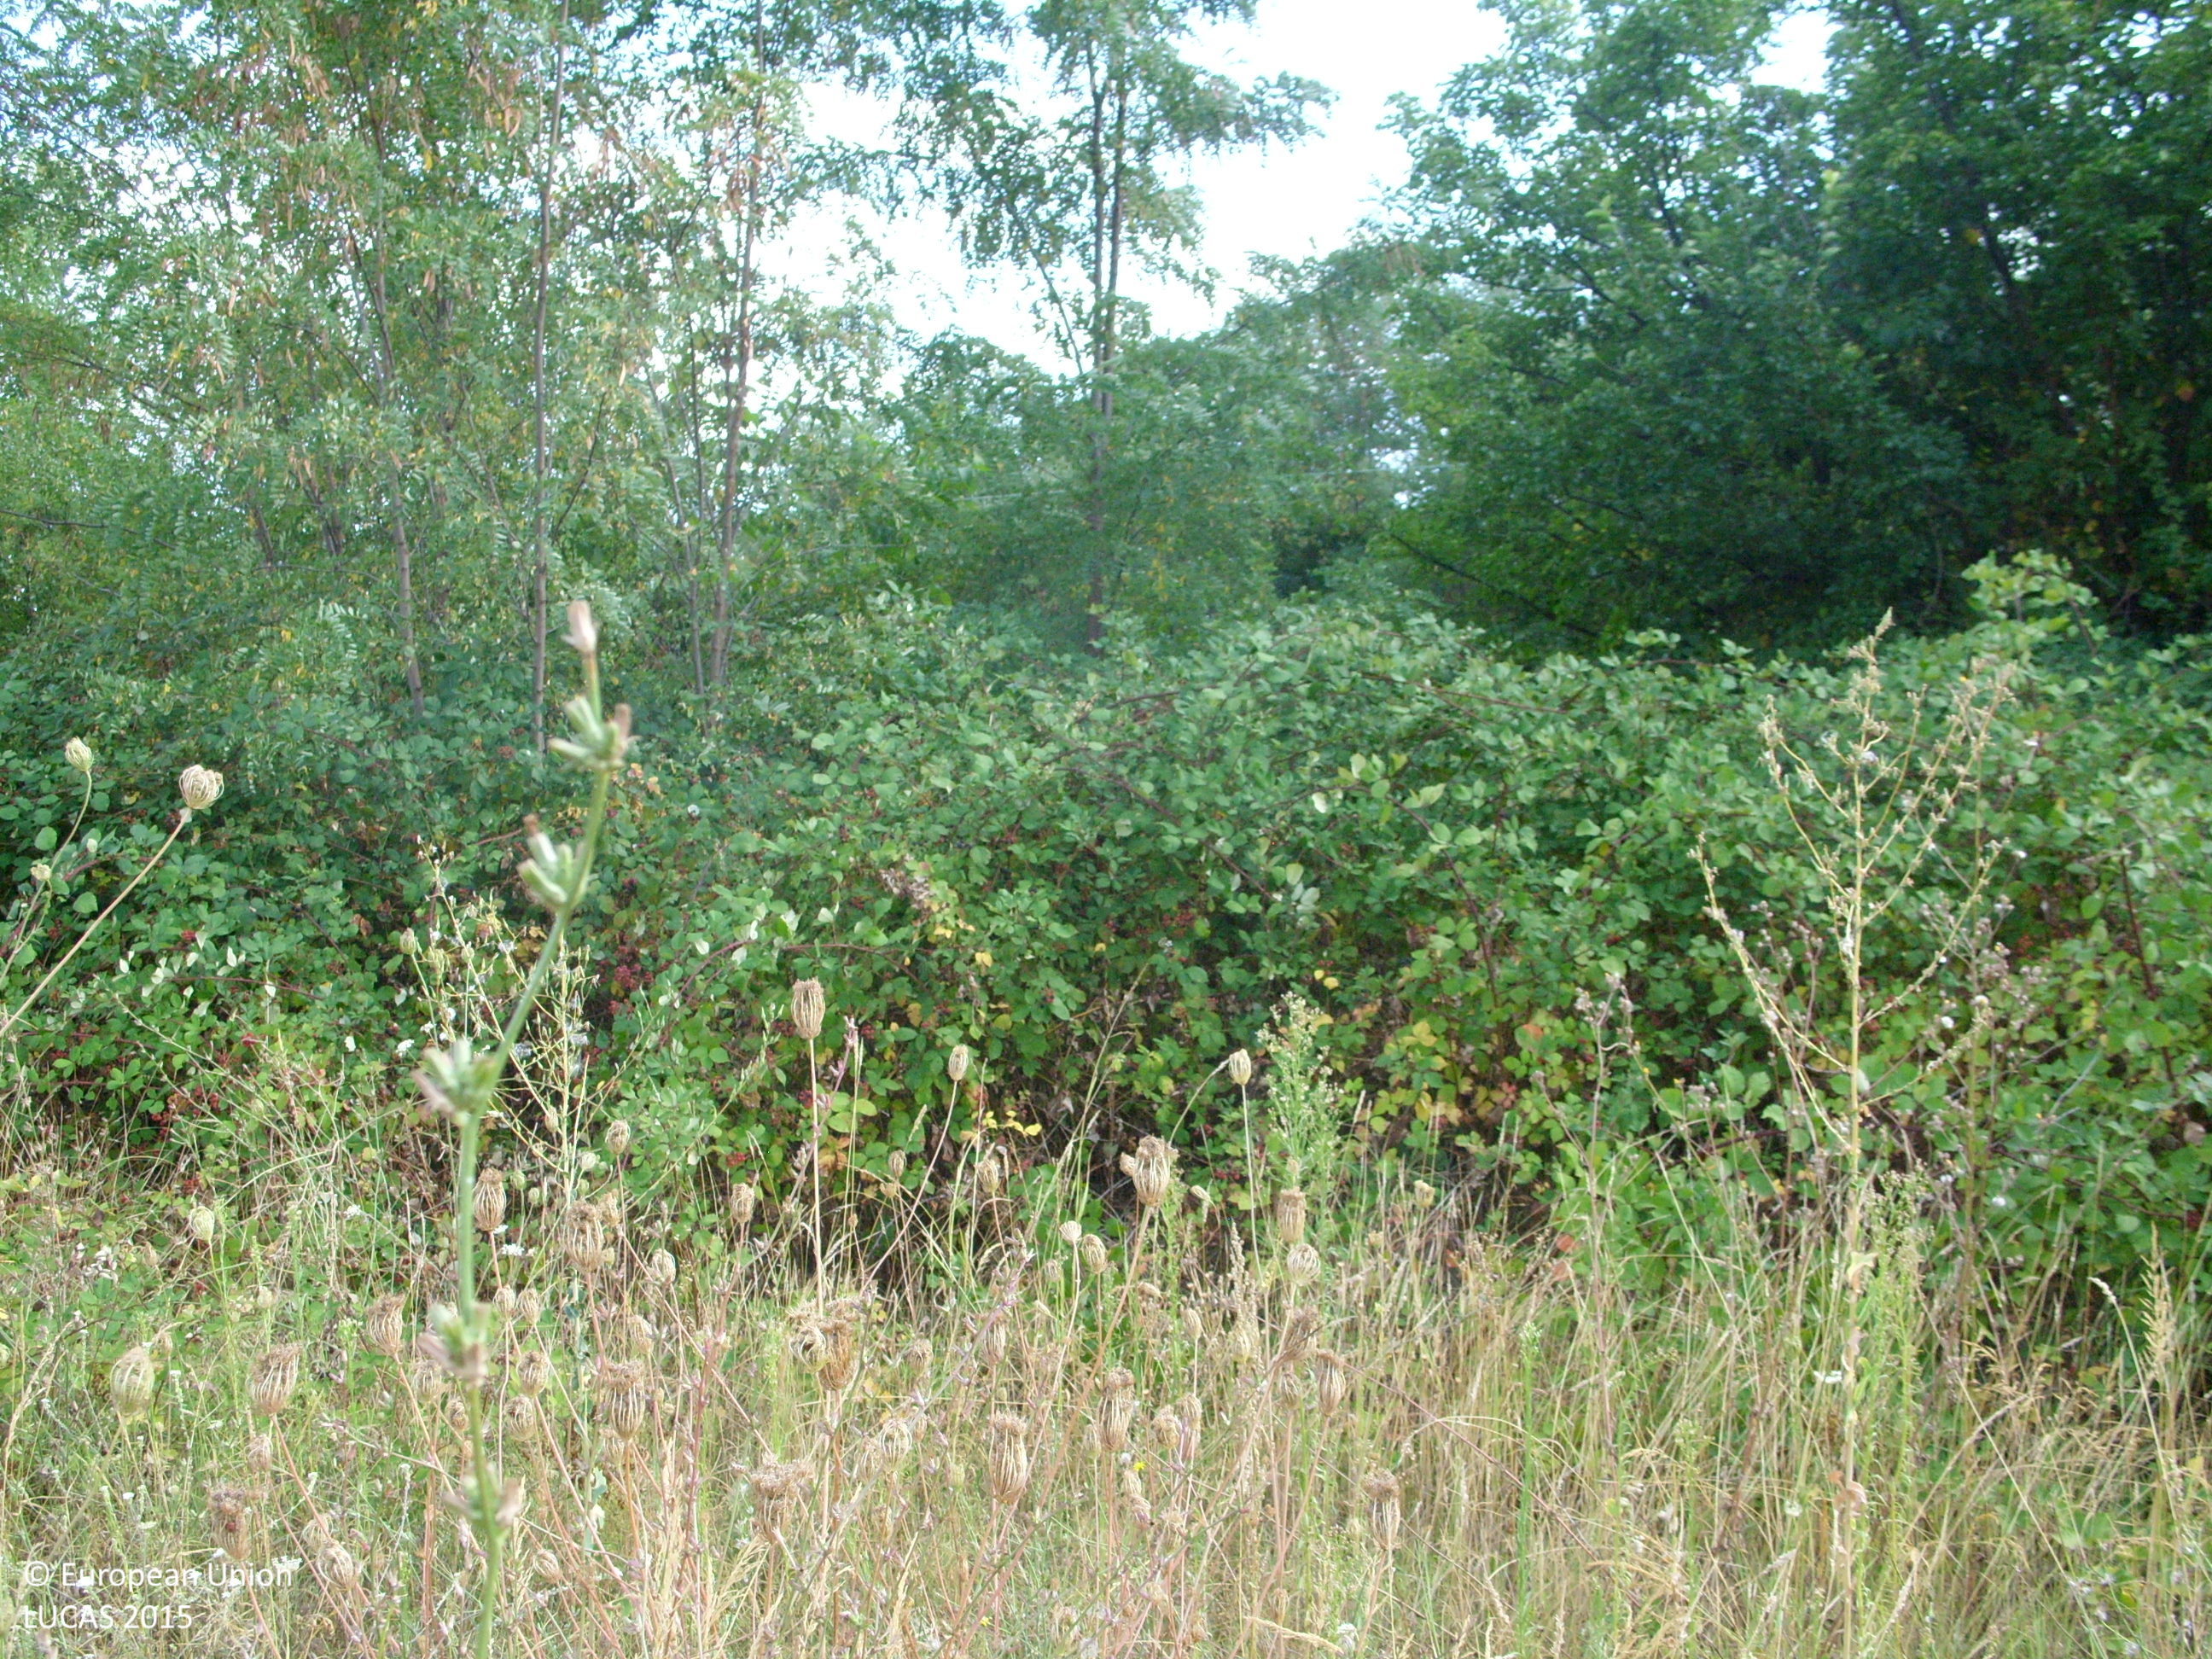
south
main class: Grassland
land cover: Spontaneously vegetated surfaces
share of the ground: > 75 %
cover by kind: herbaceous plants 100 %
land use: Fallow land
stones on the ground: < 10 %
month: August
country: BG
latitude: 42.6124
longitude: 24.8704
